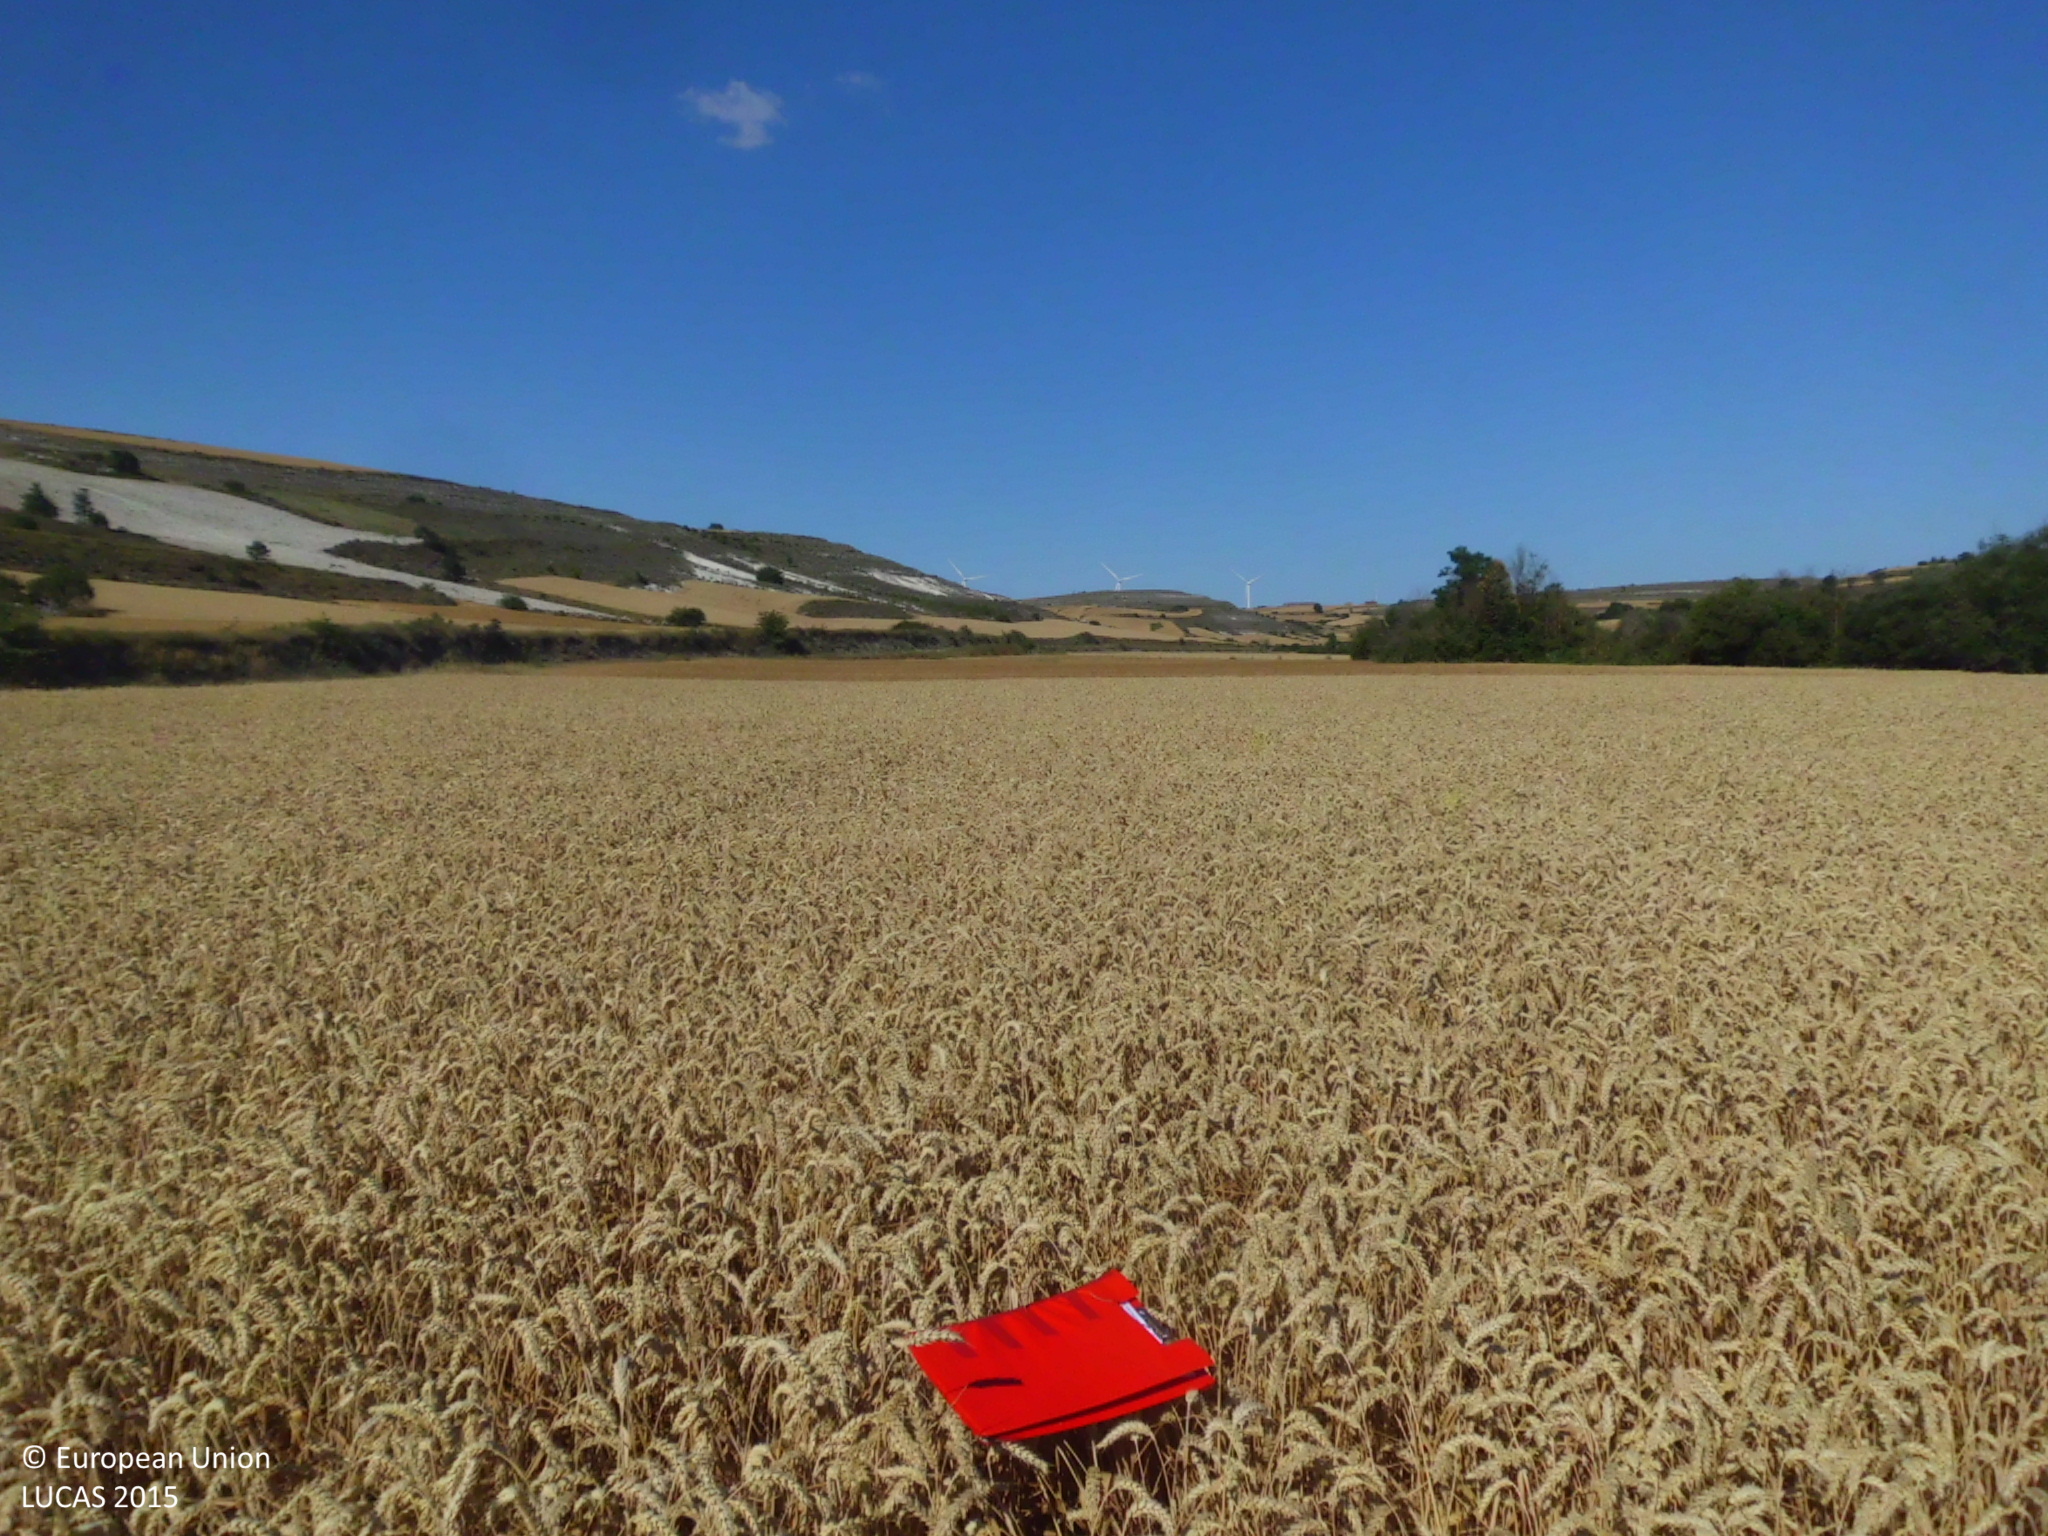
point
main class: Cropland
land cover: Common wheat
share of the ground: > 75 %
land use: Agriculture (excluding fallow land and kitchen gardens)
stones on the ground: 10 - 25 %
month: July
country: ES
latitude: 42.4245
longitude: -3.8833
